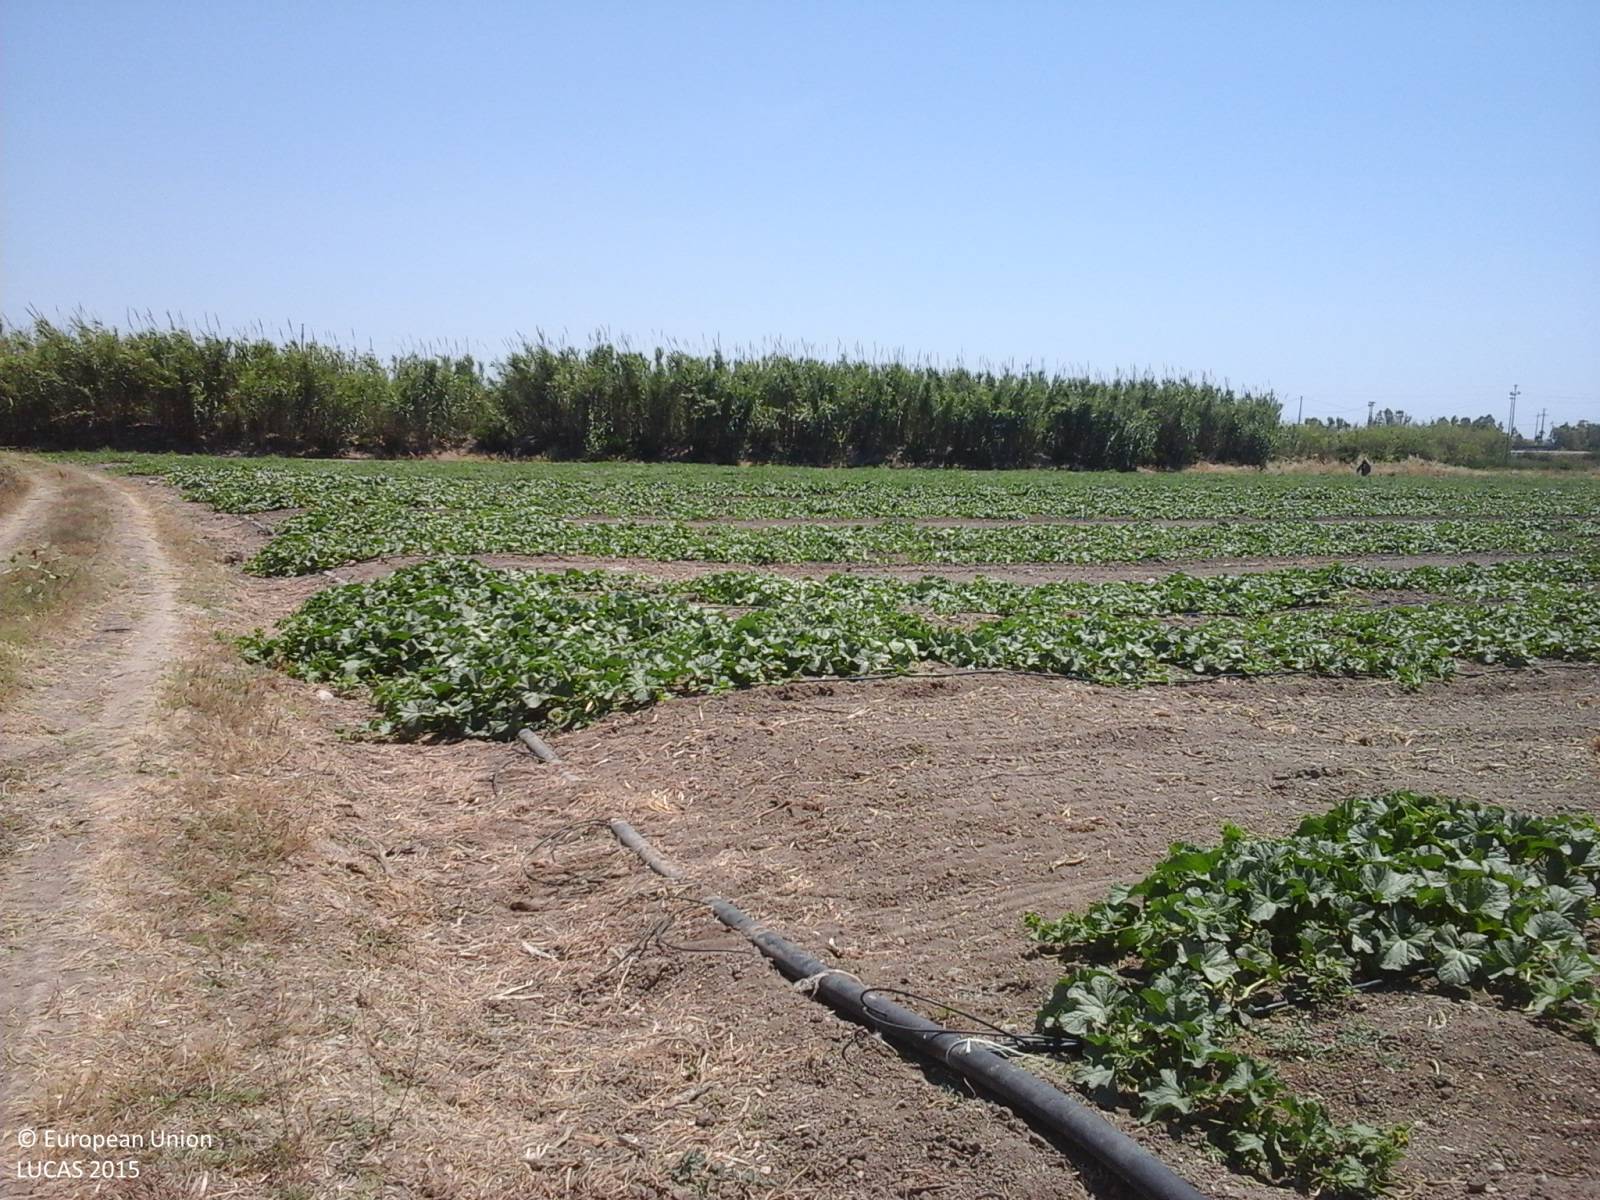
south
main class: Cropland
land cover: Other fresh vegetables
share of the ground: > 75 %
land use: Agriculture (excluding fallow land and kitchen gardens)
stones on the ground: 25 - 50 %
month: June
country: IT
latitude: 39.0611
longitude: 8.5645
